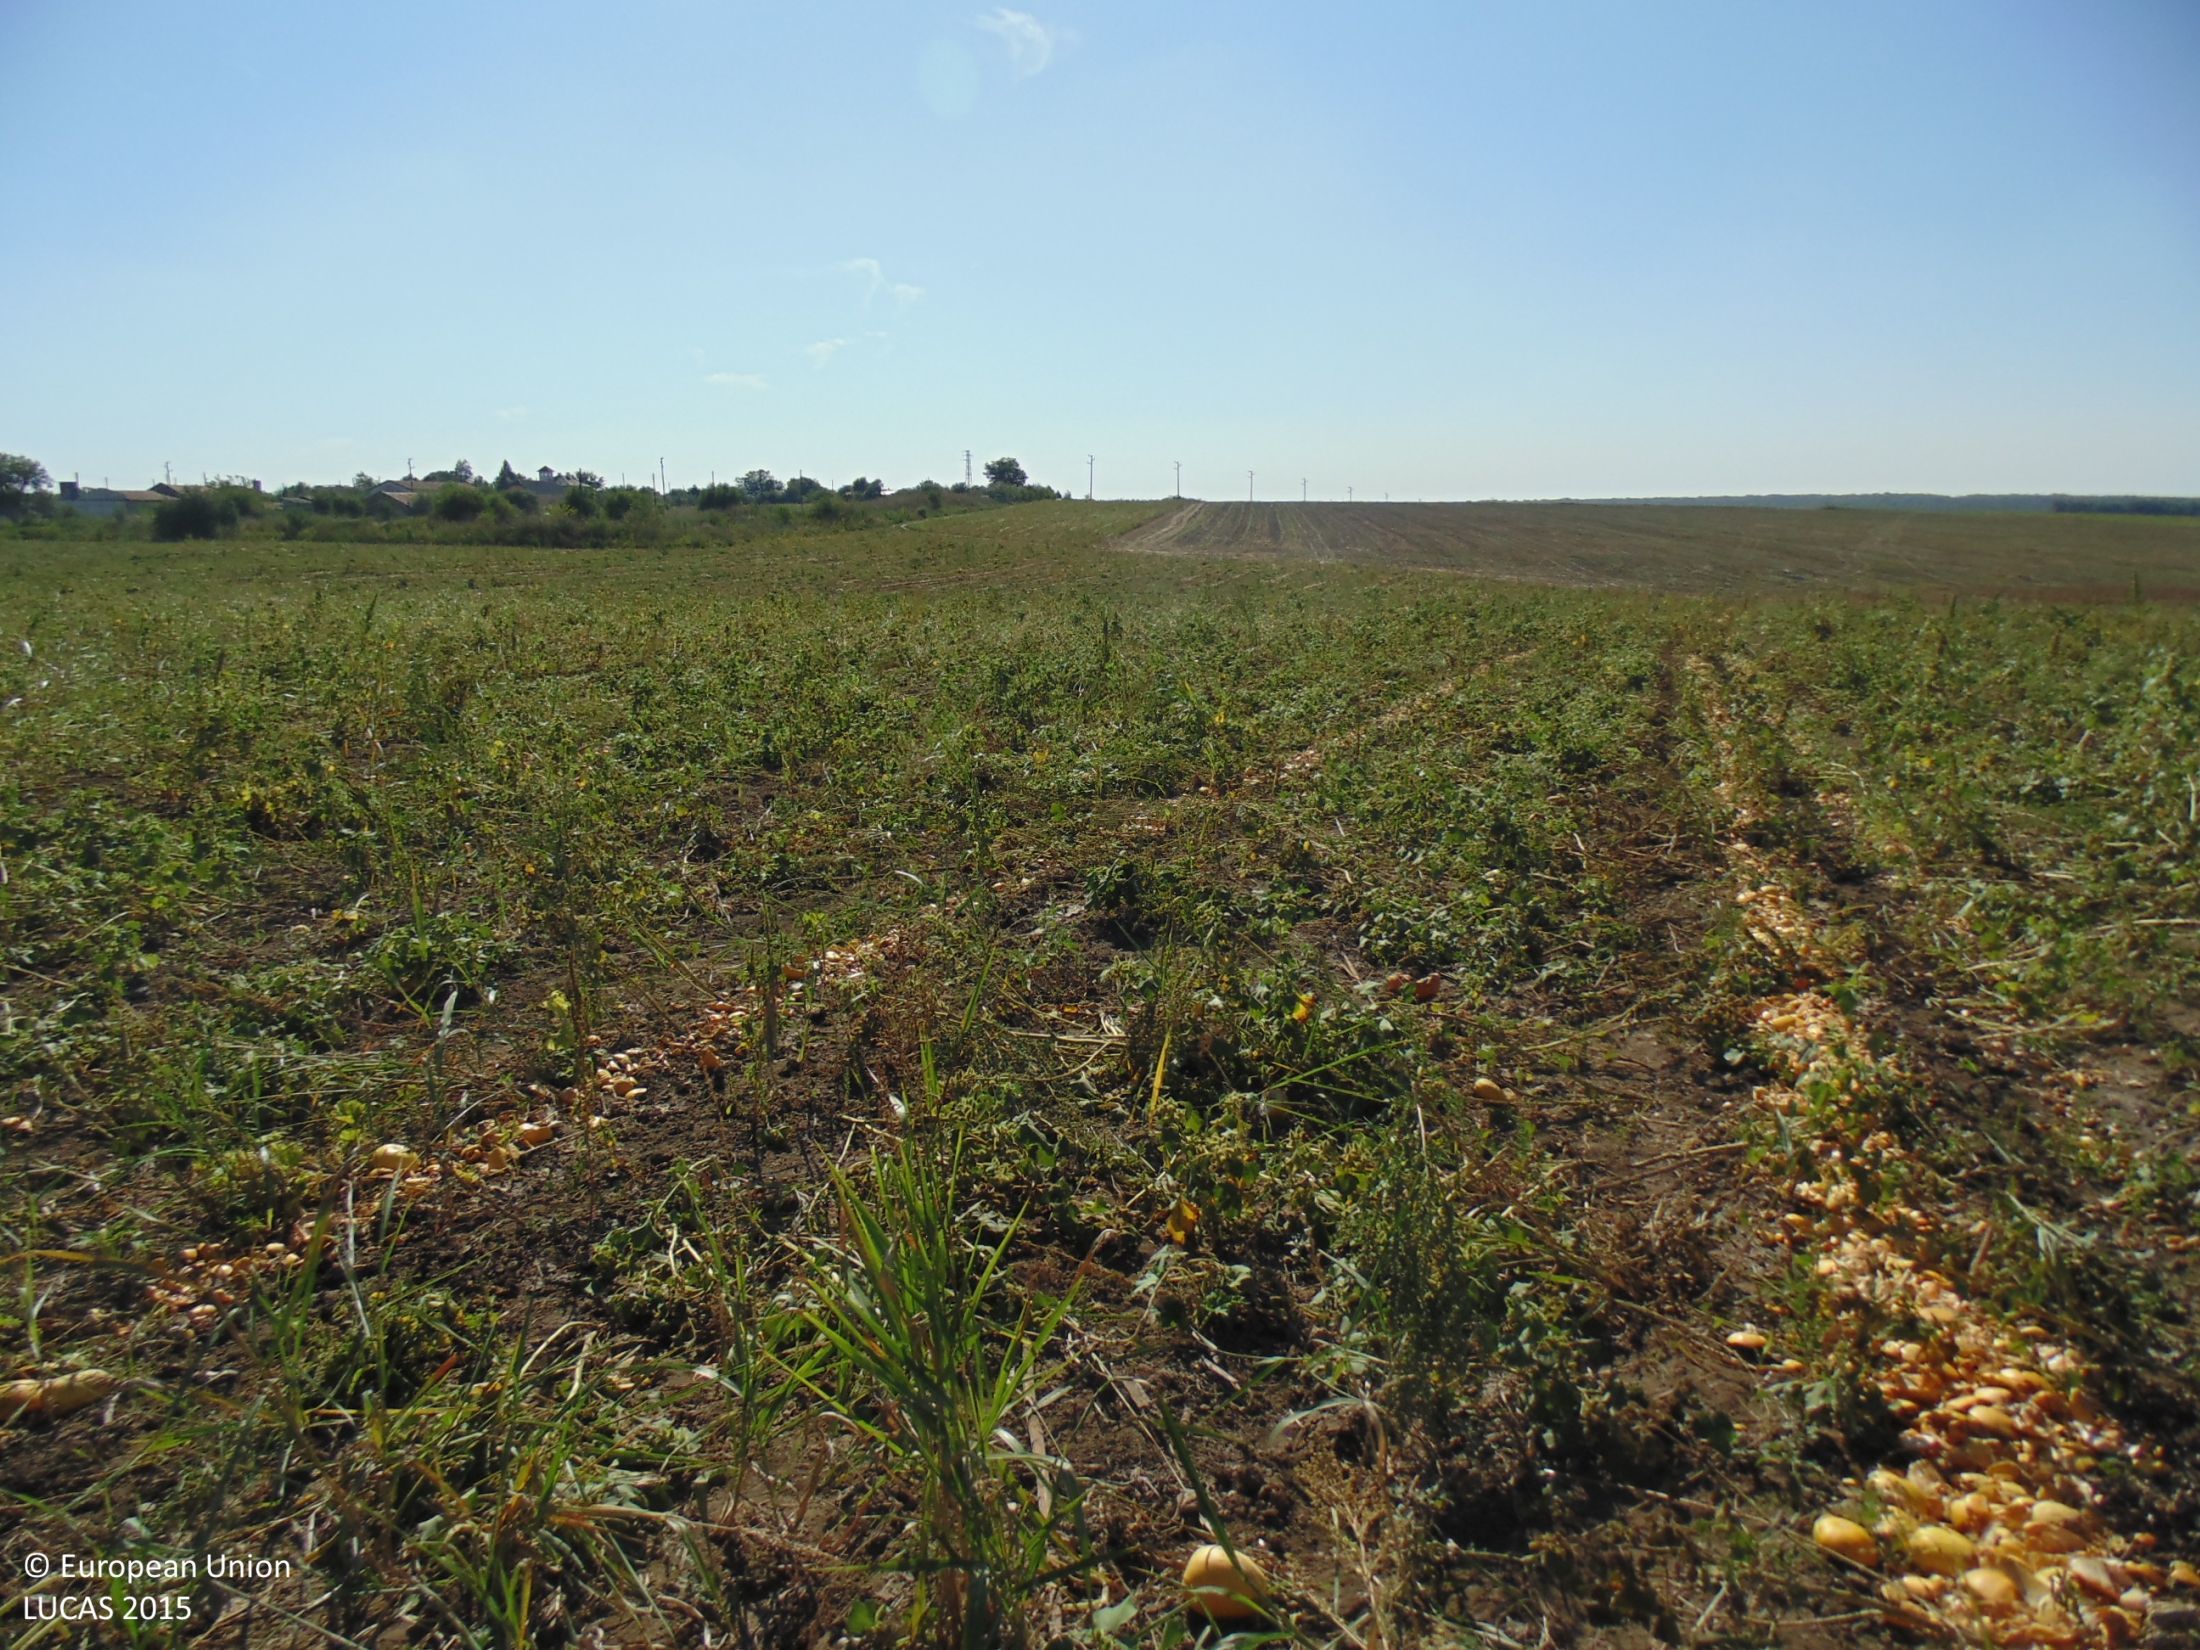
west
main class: Cropland
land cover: Other fresh vegetables
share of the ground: 10 - 25 %
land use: Agriculture (excluding fallow land and kitchen gardens)
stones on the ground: < 10 %
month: September
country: BG
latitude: 43.8804
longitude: 26.9601
